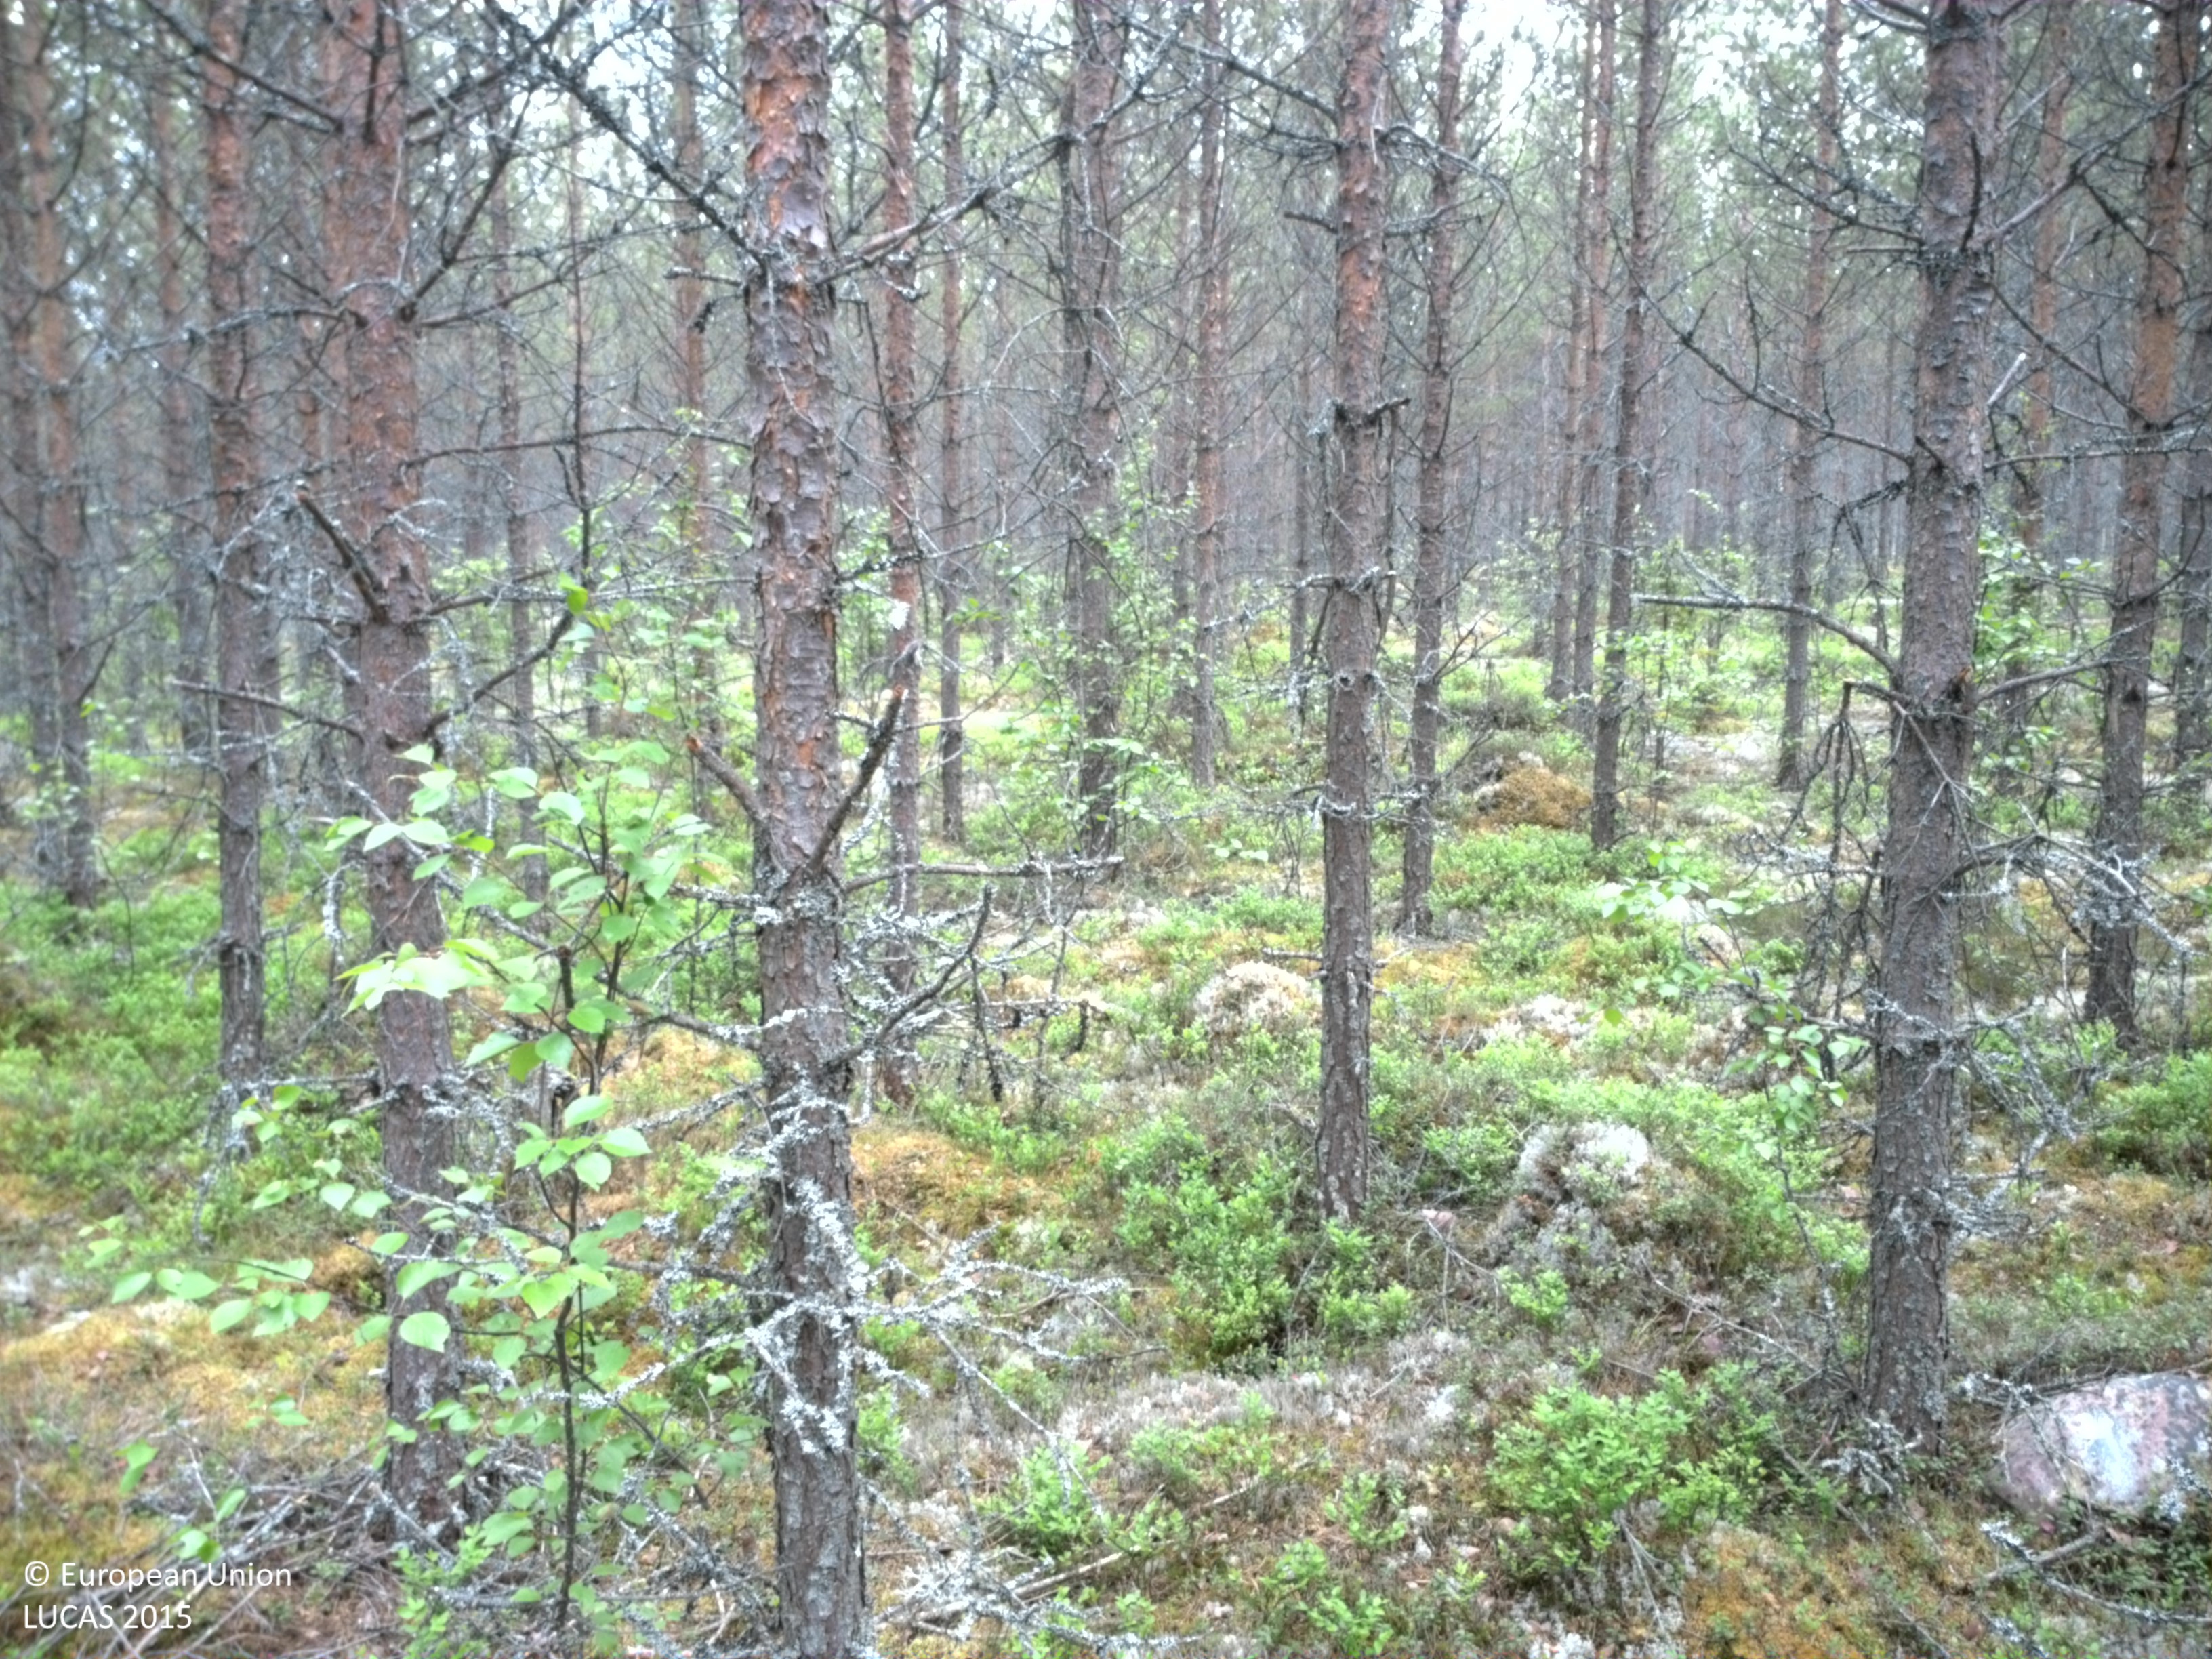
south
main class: Woodland
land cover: Pine dominated coniferous woodland
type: boreal forest
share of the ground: > 75 %
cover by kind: coniferous forest trees 80 %, lichens and mosses 20 %
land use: Forestry
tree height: < 5 m
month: June
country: SE
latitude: 61.2896
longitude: 13.5519
